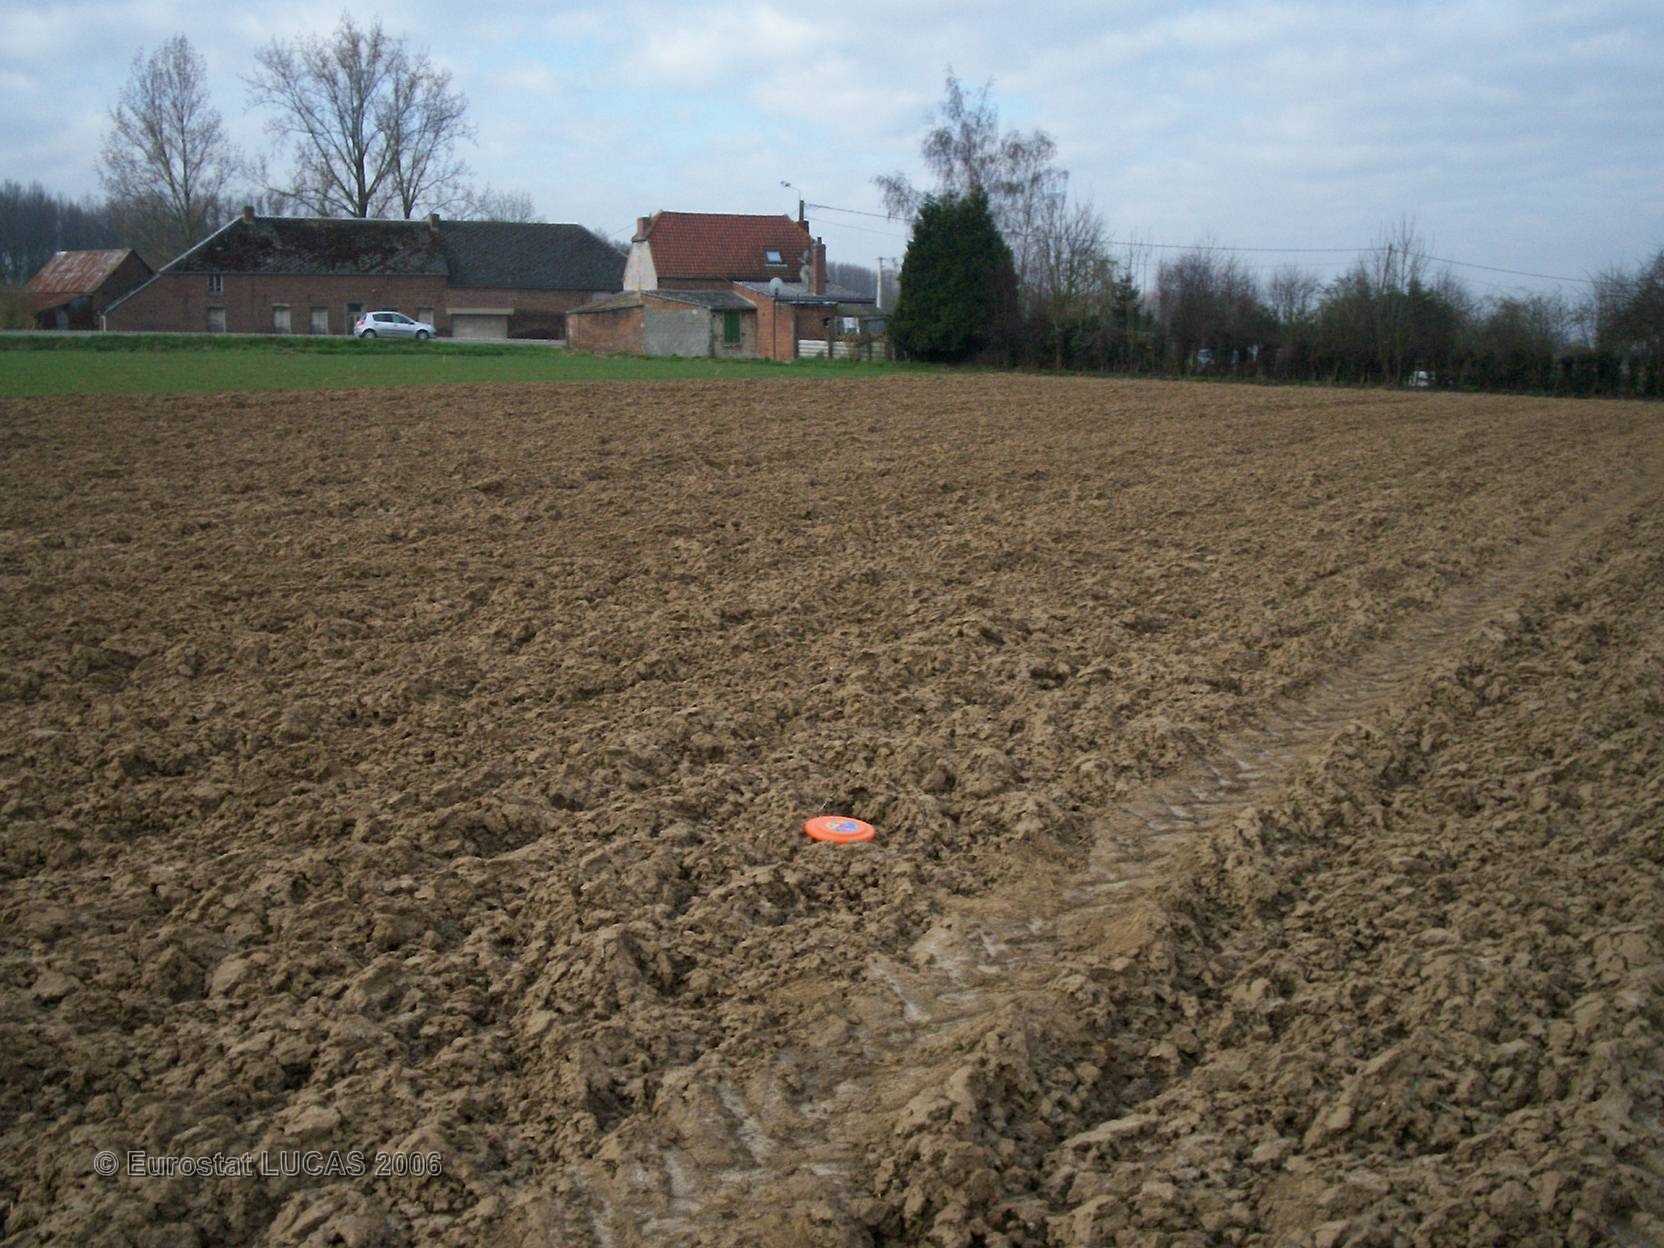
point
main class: Cropland
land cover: Maize
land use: Agriculture (excluding fallow land and kitchen gardens)
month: April
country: FR
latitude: 50.2981
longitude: 3.6899
